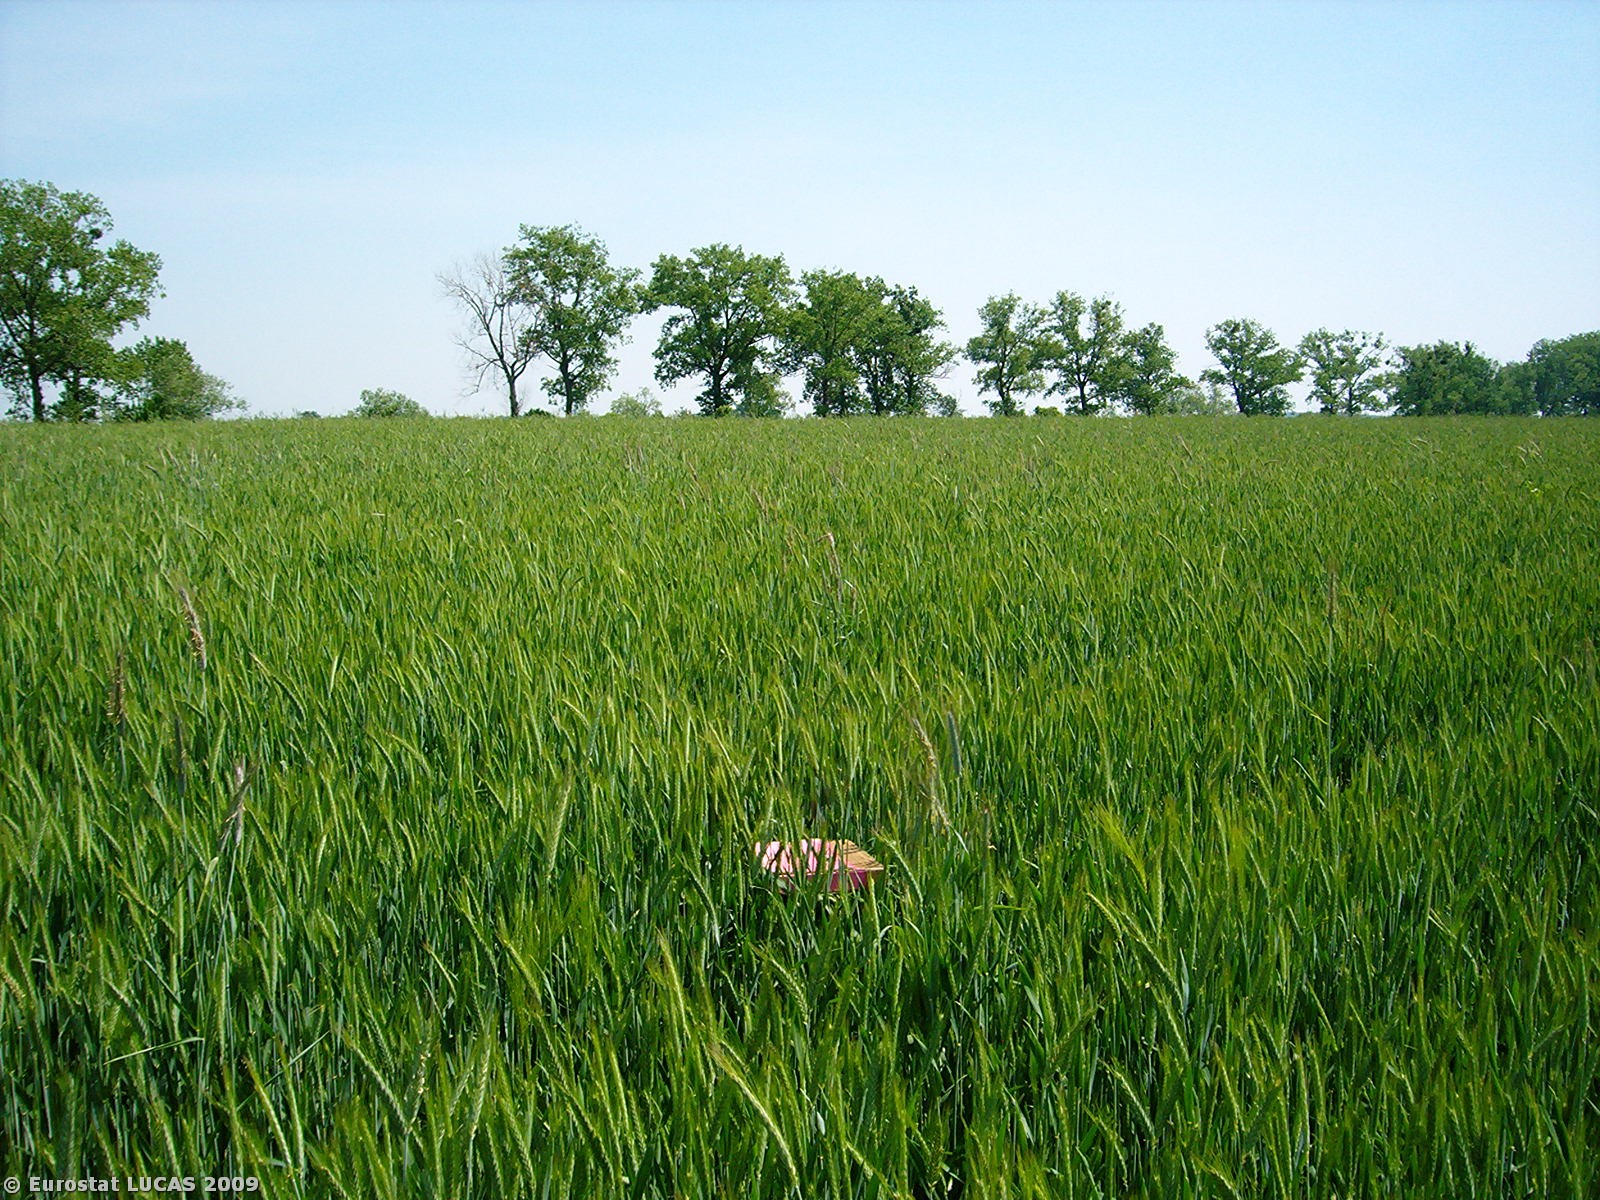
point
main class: Cropland
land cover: Rye
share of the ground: > 75 %
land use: Agriculture (excluding fallow land and kitchen gardens)
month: May
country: PL
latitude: 52.5299
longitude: 16.3898
